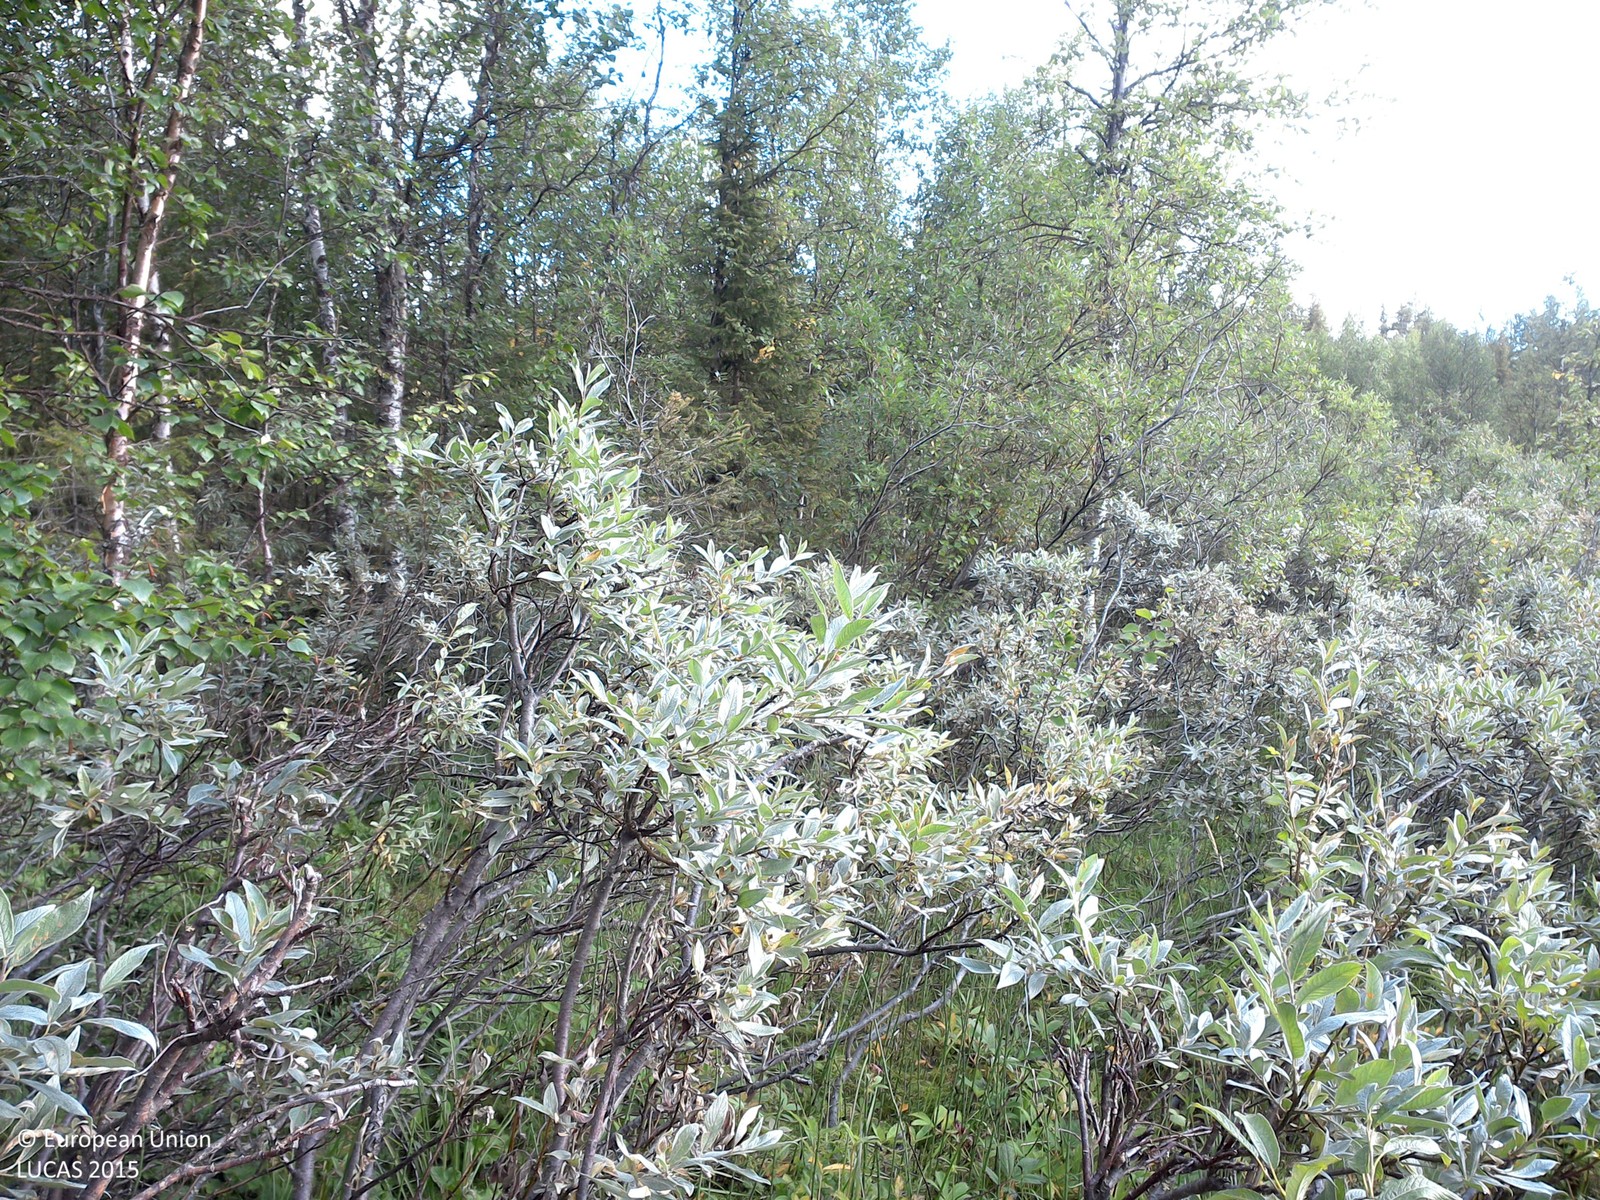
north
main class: Woodland
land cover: Broadleaved woodland
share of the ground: 50 - 75 %
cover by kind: broadleaved forest trees 55 %, shrubs 40 %, herbaceous plants 5 %
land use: Semi-natural and natural areas not in use
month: August
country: SE
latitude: 67.3837
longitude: 21.8144
